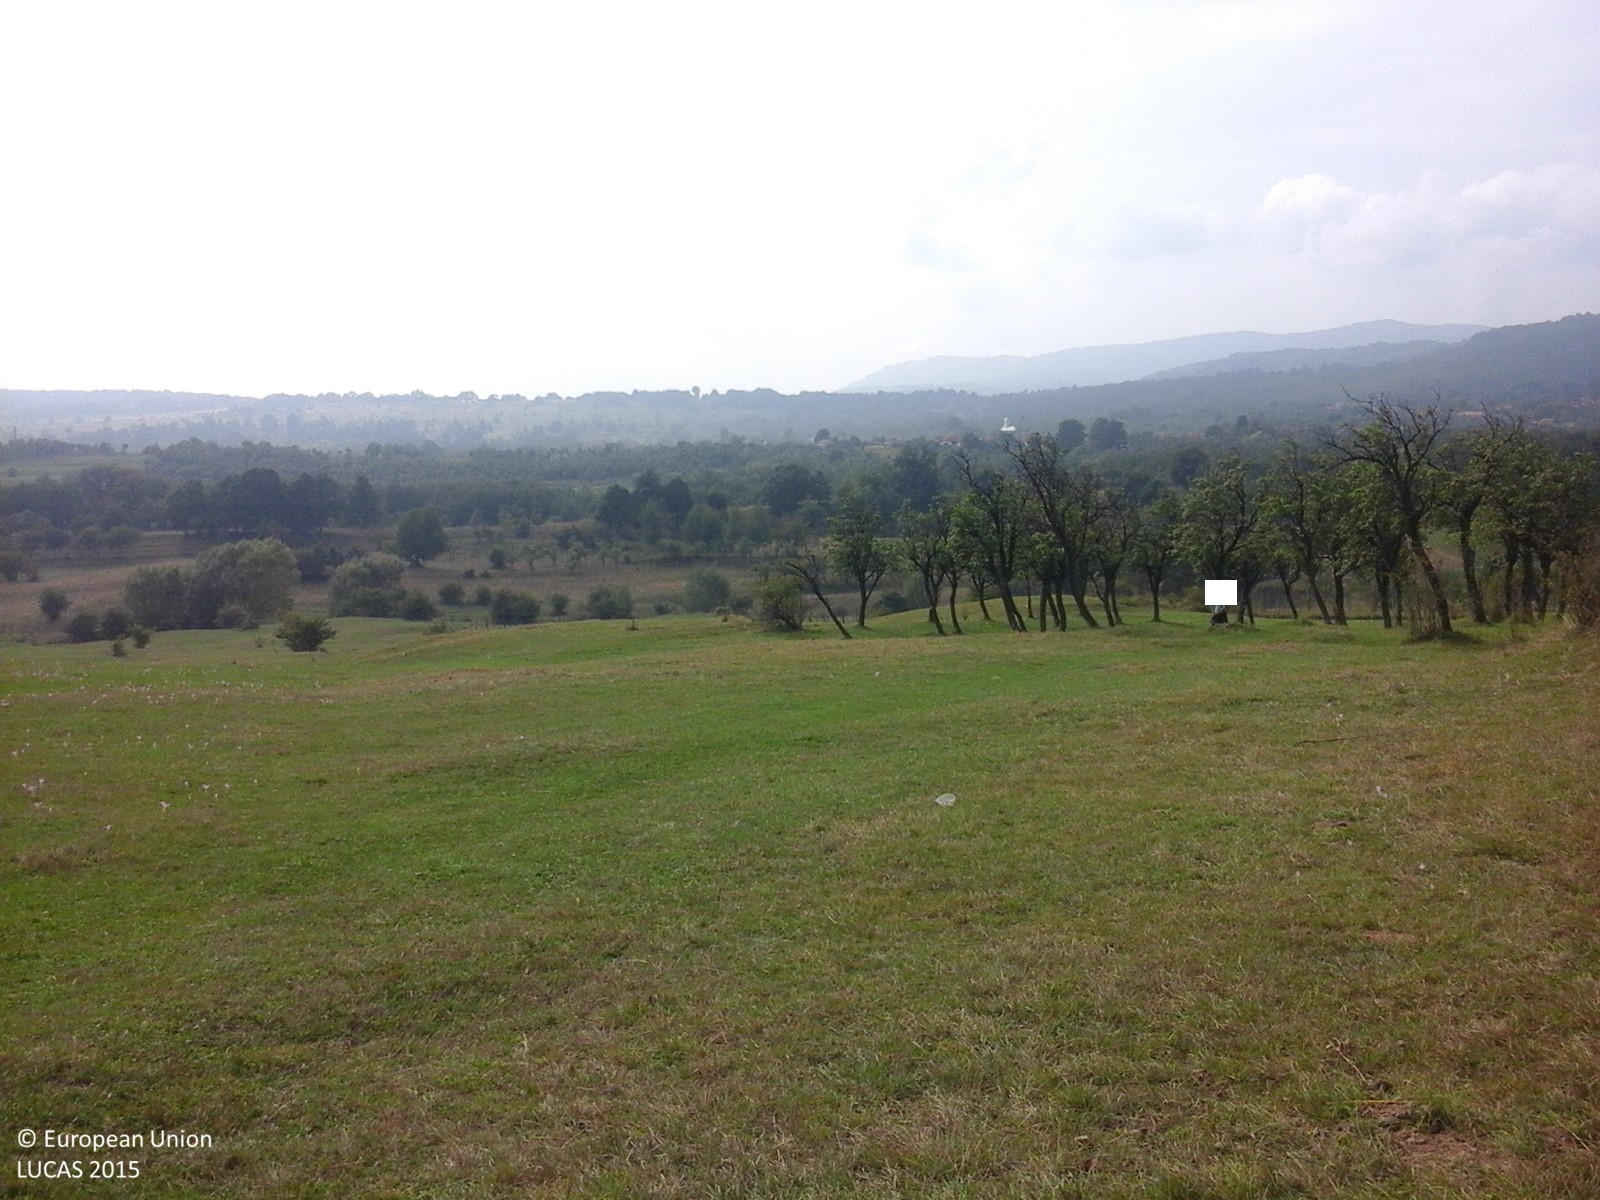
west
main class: Grassland
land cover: Grassland without tree/shrub cover
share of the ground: > 75 %
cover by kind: herbaceous plants 100 %
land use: Agriculture (excluding fallow land and kitchen gardens)
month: September
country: RO
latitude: 45.1582
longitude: 23.2459
